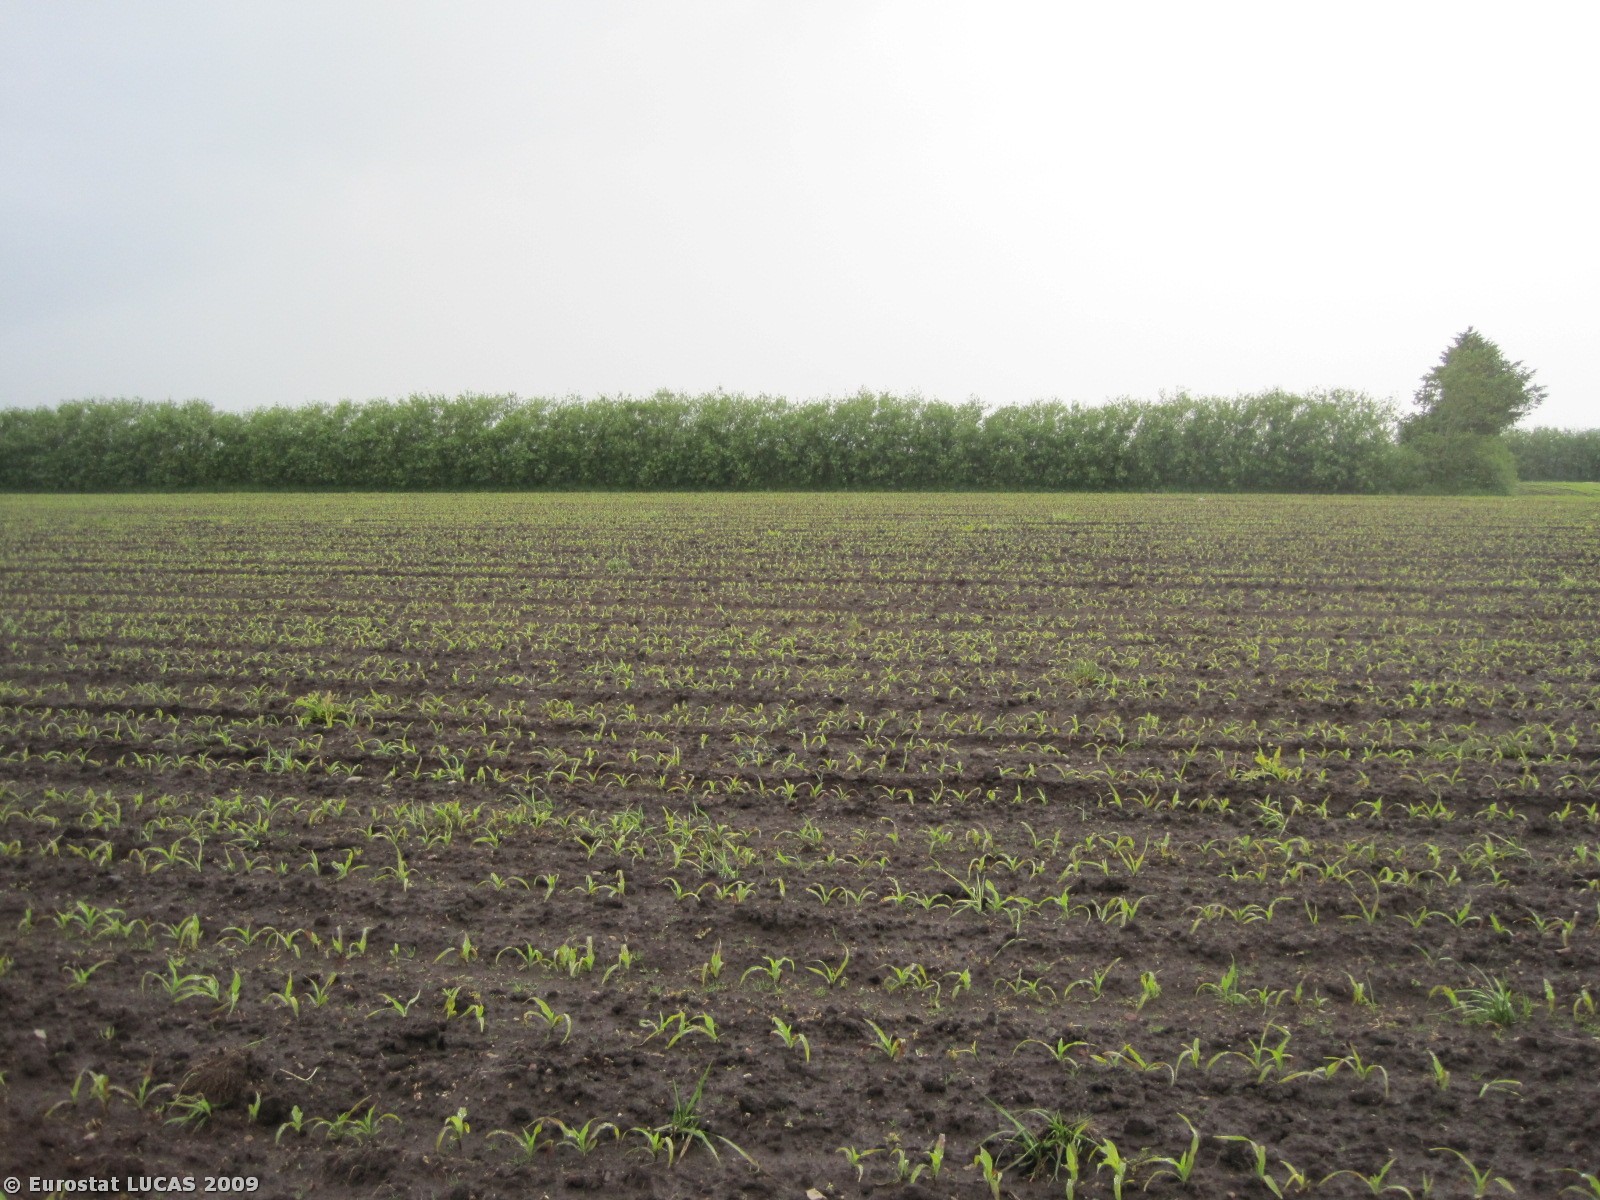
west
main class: Cropland
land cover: Maize
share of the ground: < 10 %
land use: Agriculture (excluding fallow land and kitchen gardens)
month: June
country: DK
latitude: 57.3922
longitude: 10.0831
